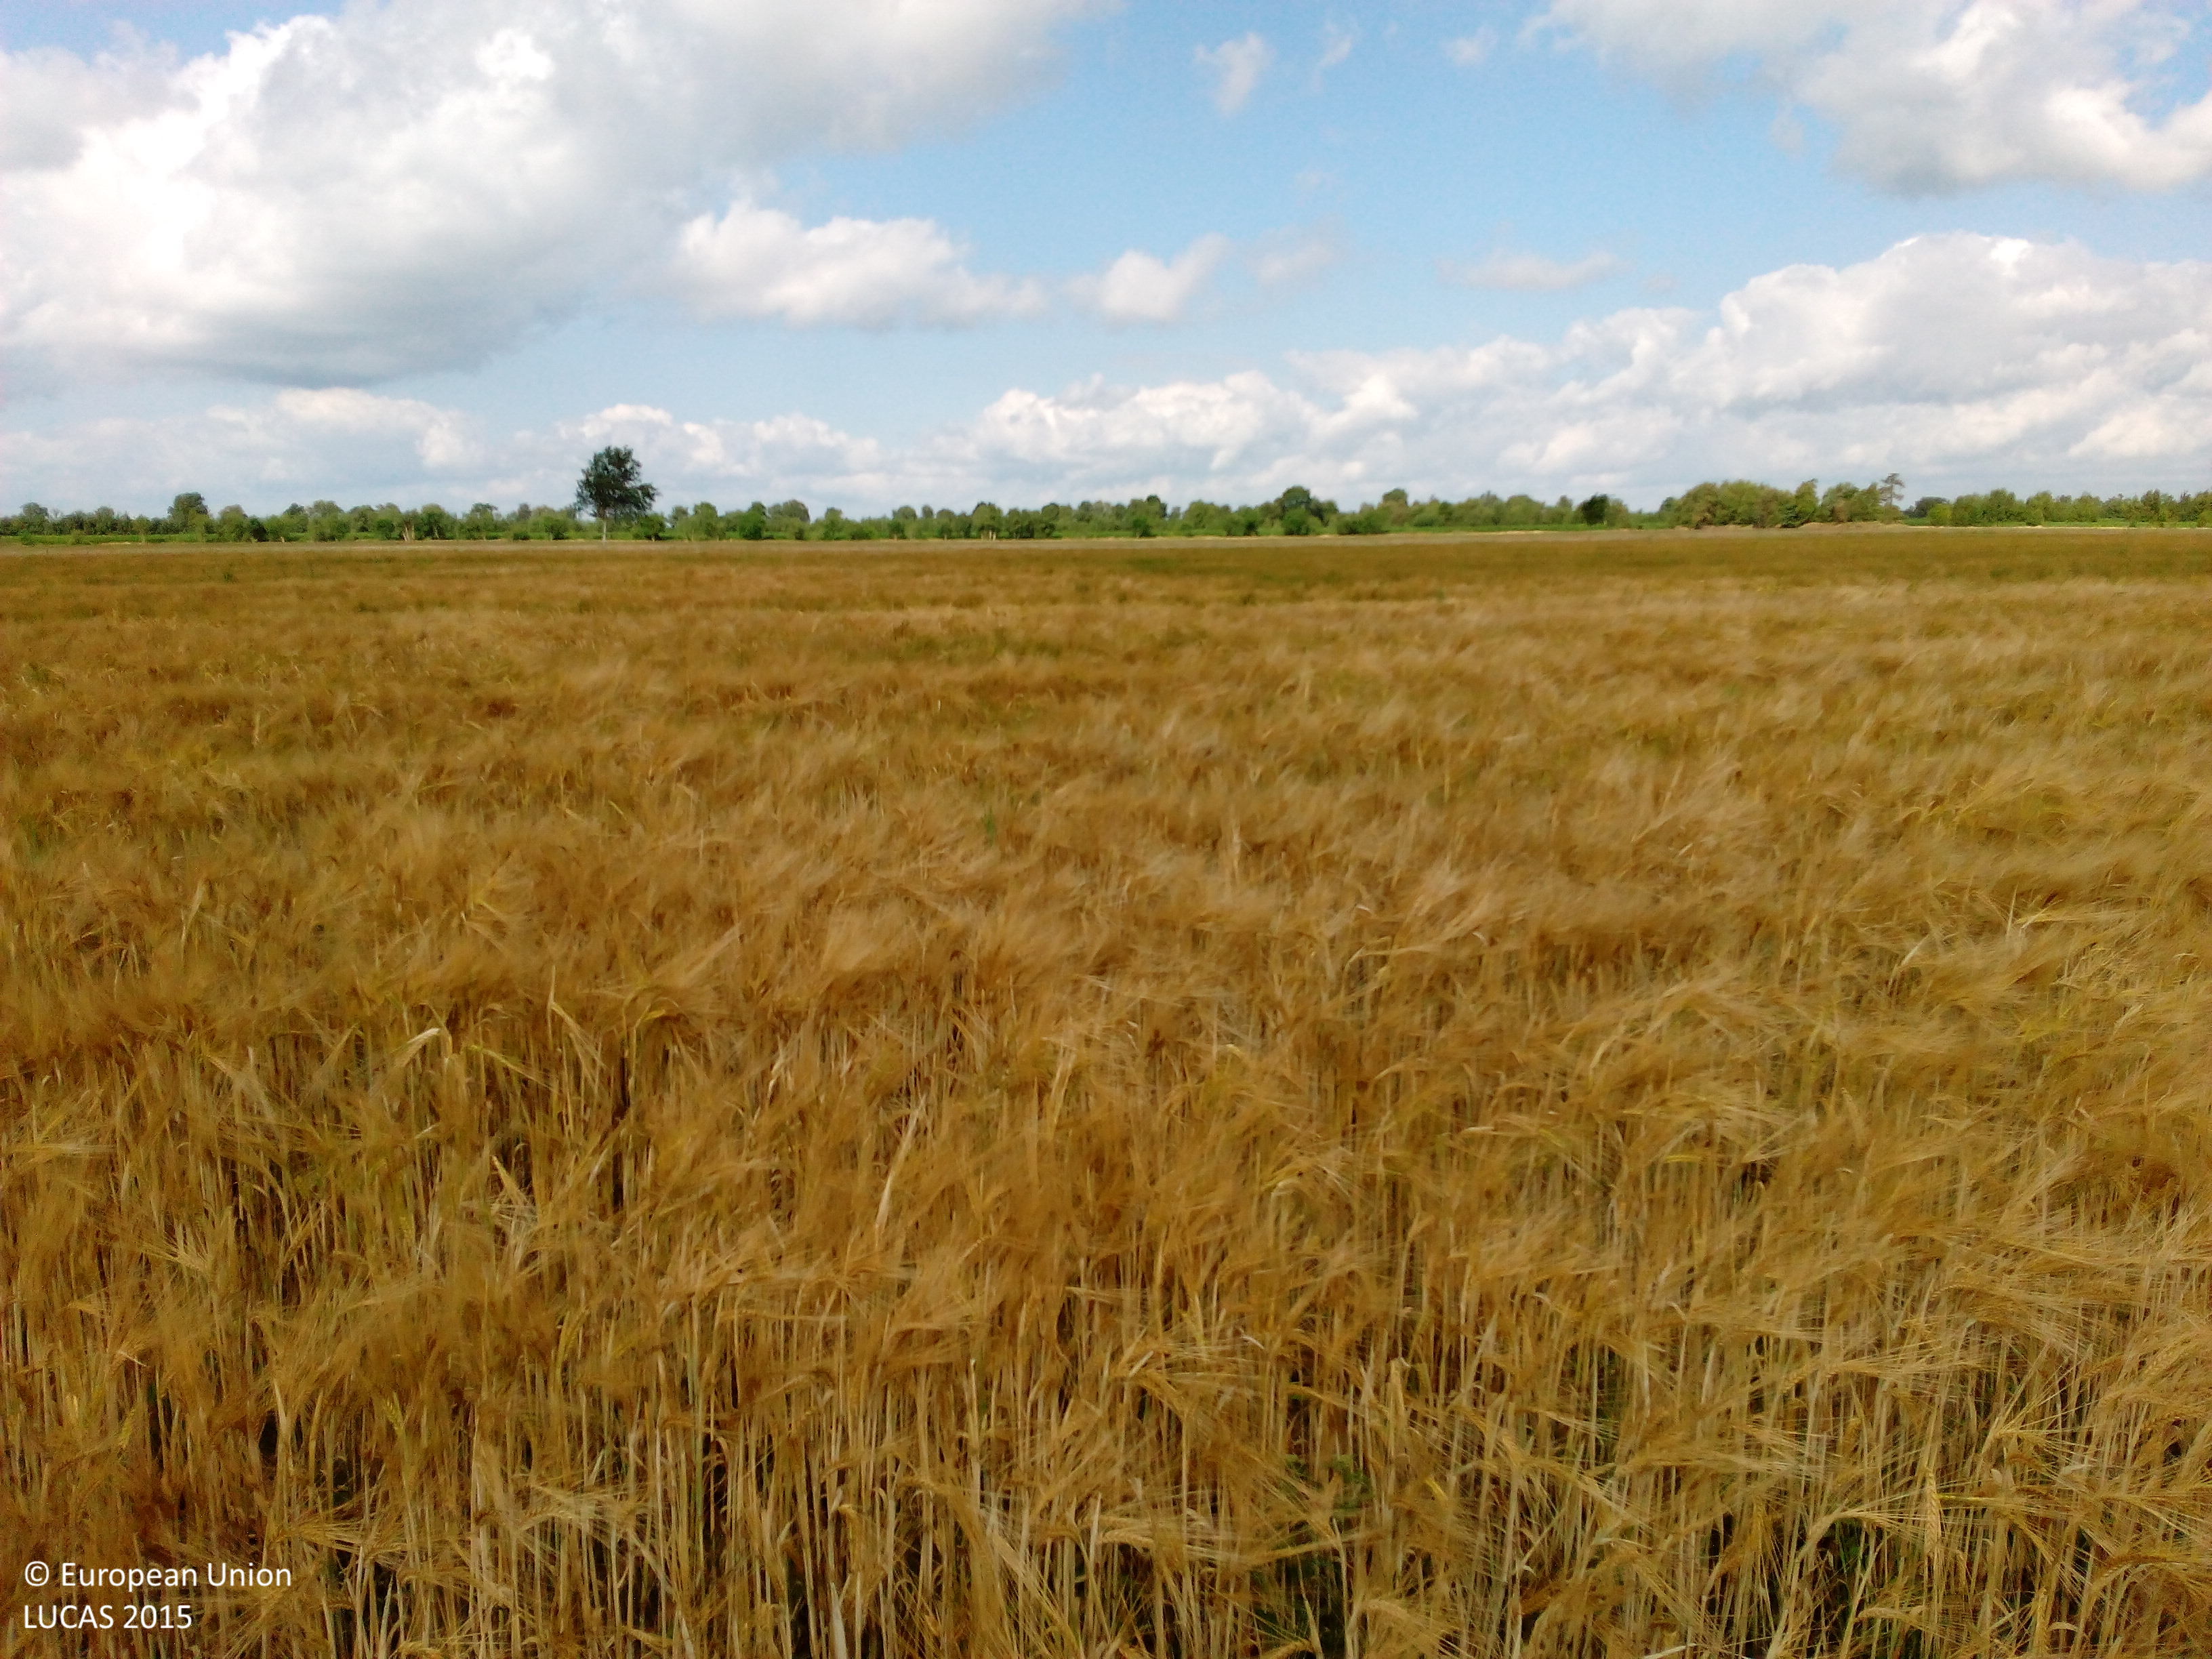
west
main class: Cropland
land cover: Barley
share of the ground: > 75 %
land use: Agriculture (excluding fallow land and kitchen gardens)
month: July
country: DE
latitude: 53.0960
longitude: 7.8950
